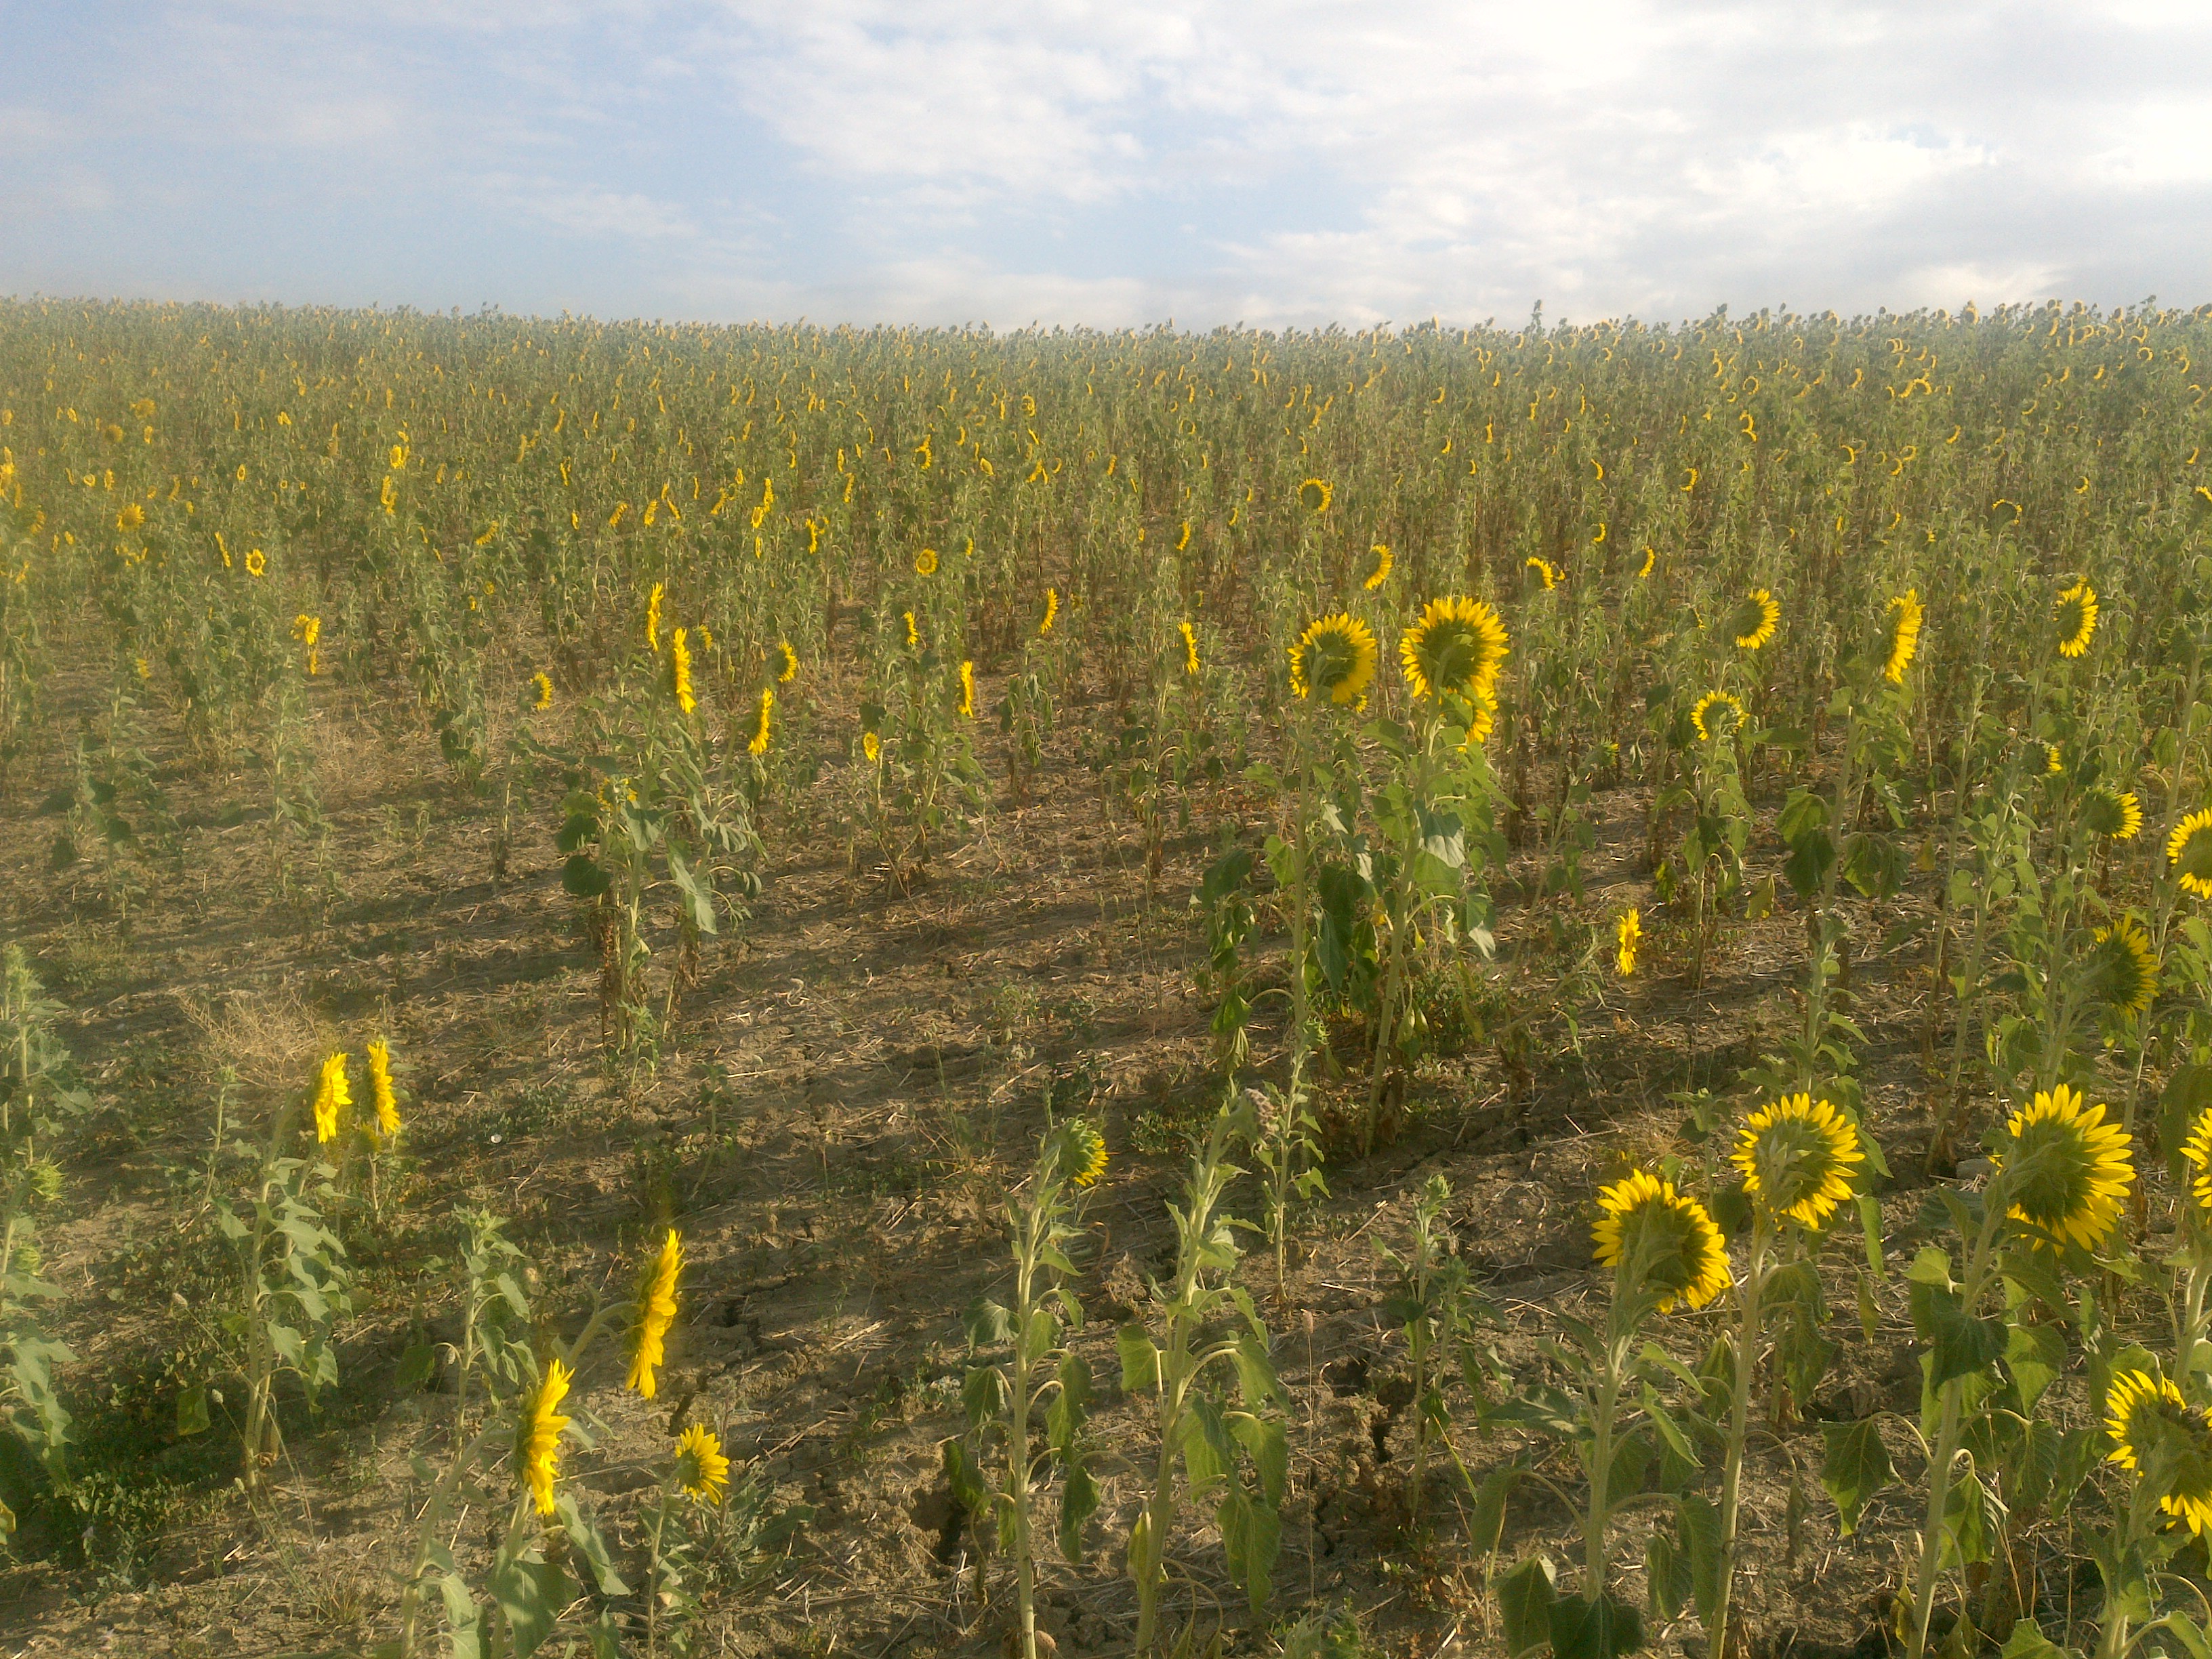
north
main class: Cropland
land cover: Sunflower
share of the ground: > 75 %
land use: Agriculture (excluding fallow land and kitchen gardens)
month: June
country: ES
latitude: 37.9254
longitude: -4.5627
